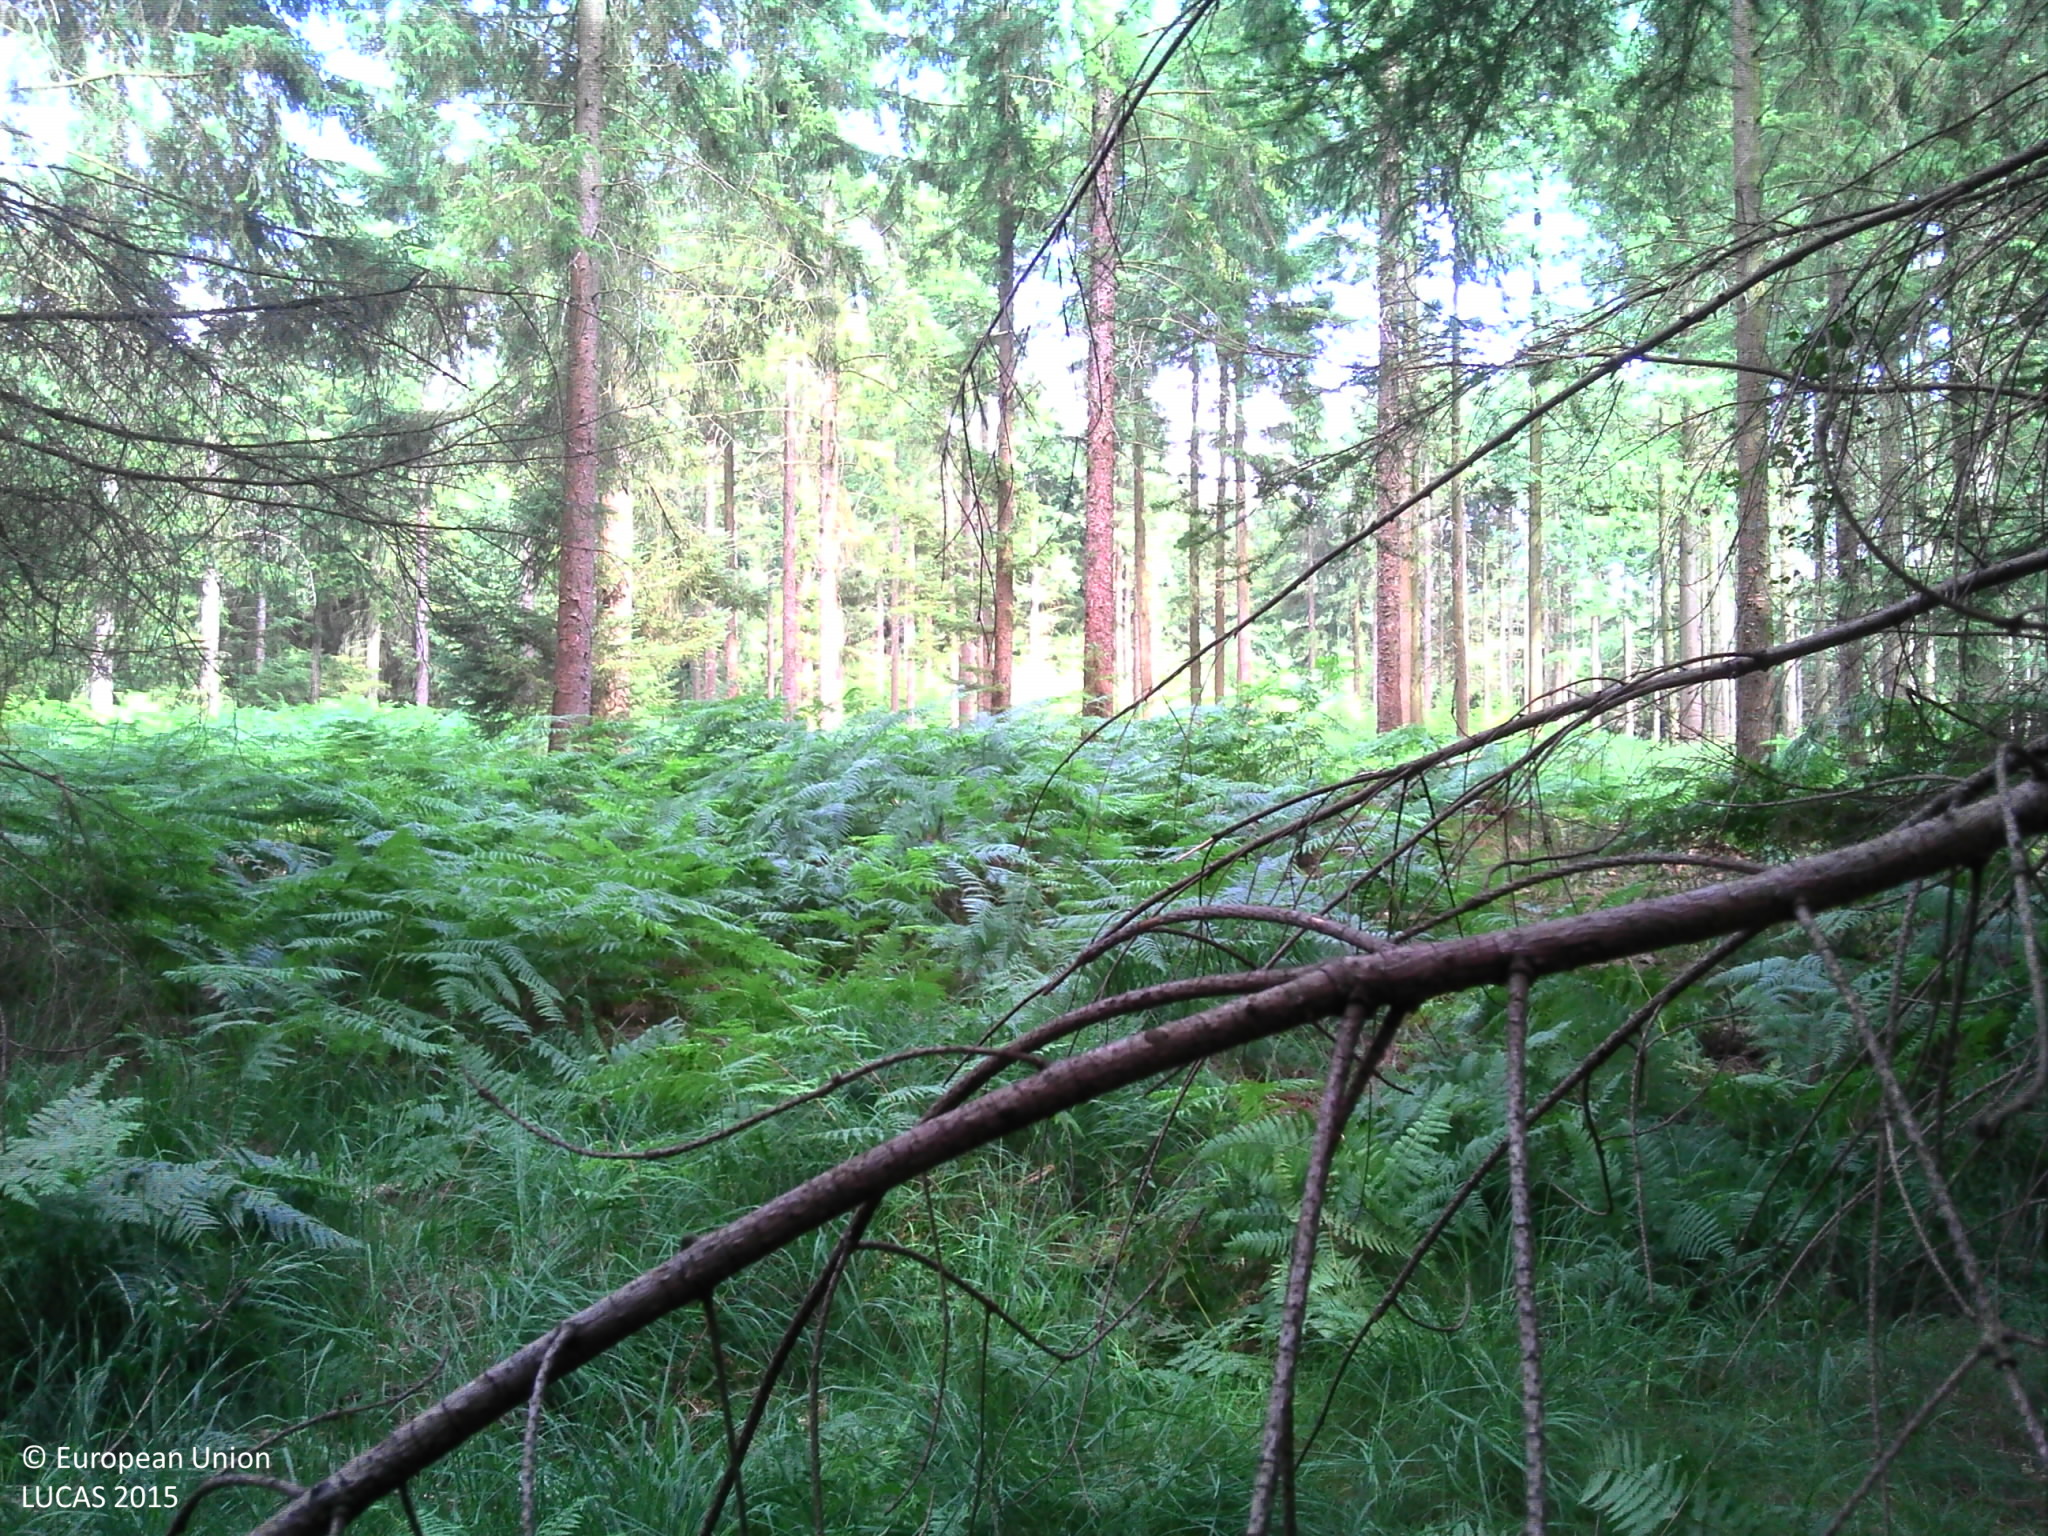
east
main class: Woodland
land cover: Spruce dominated coniferous woodland
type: mesophytic deciduous forest
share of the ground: > 75 %
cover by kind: coniferous forest trees 95 %, herbaceous plants 5 %
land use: Forestry
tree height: > 5 m
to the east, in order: Spruce dominated coniferous woodland; Tracks; Spruce dominated coniferous woodland
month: August
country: FR
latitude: 48.5111
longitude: -0.1976
